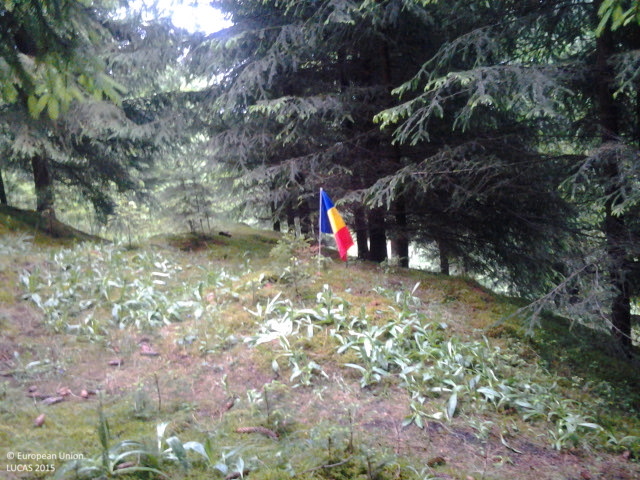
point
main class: Woodland
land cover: Spruce dominated coniferous woodland
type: alpine coniferous forest
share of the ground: > 75 %
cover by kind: coniferous forest trees 100 %
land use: Forestry
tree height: > 5 m
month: June
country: RO
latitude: 47.3034
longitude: 25.3610
